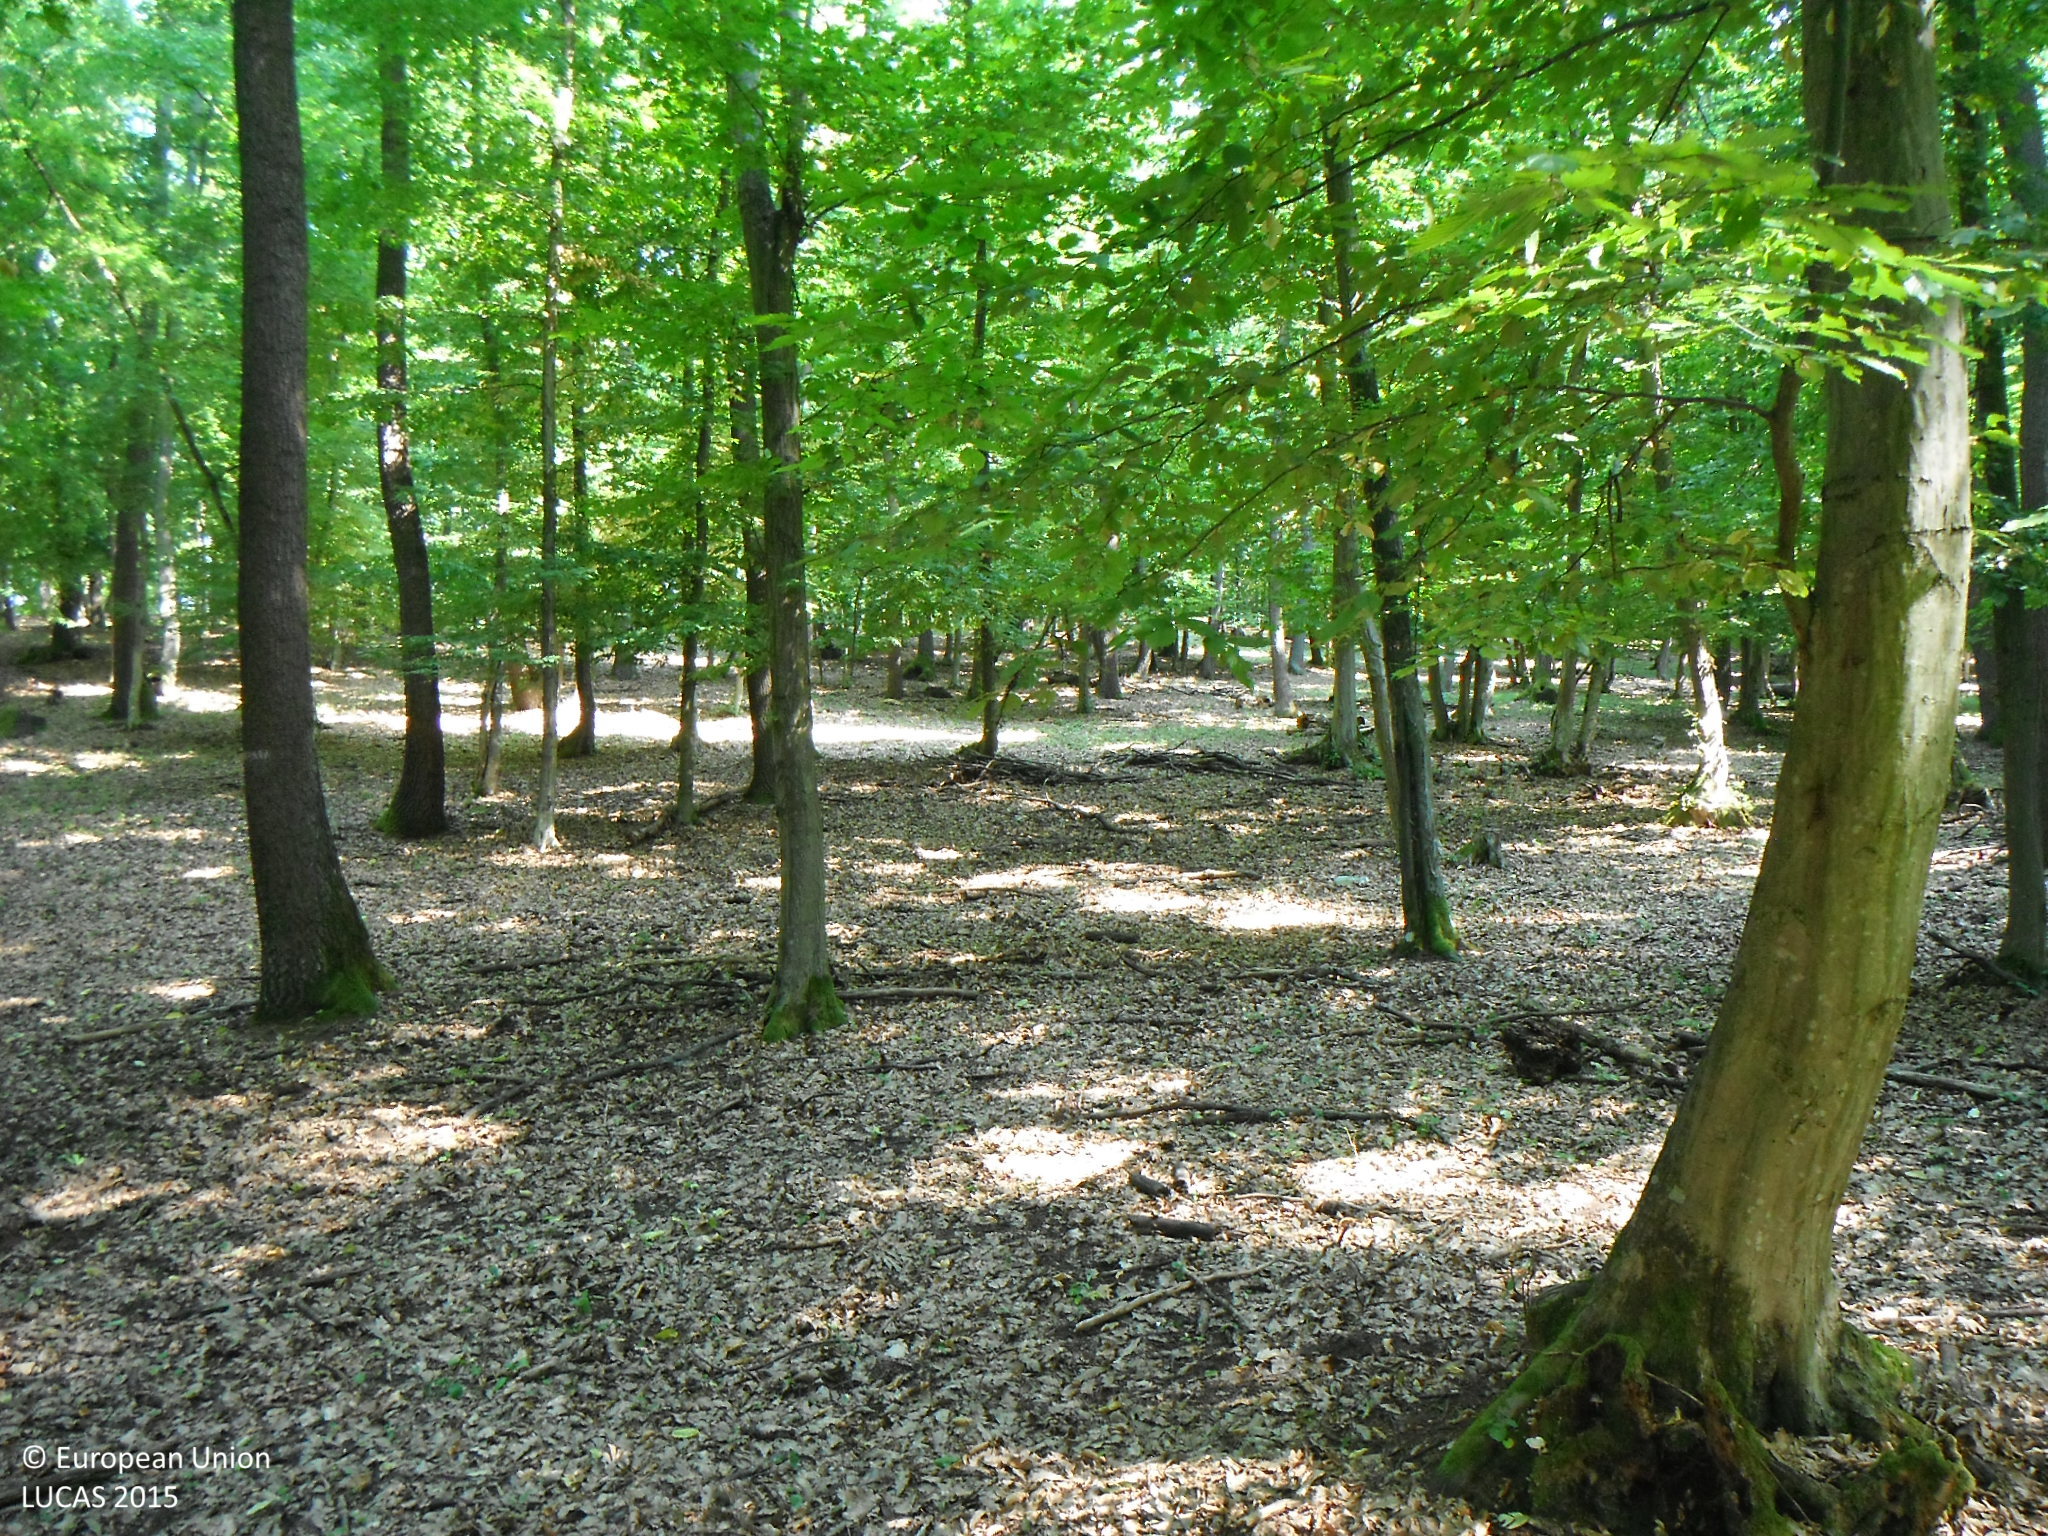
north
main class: Woodland
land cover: Broadleaved woodland
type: acidophilous oak and oak-birch forest
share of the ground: > 75 %
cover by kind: broadleaved forest trees 90 %, unconsolidated bare surface 10 %
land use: Forestry
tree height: > 5 m
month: July
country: SK
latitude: 48.3736
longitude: 20.1150
